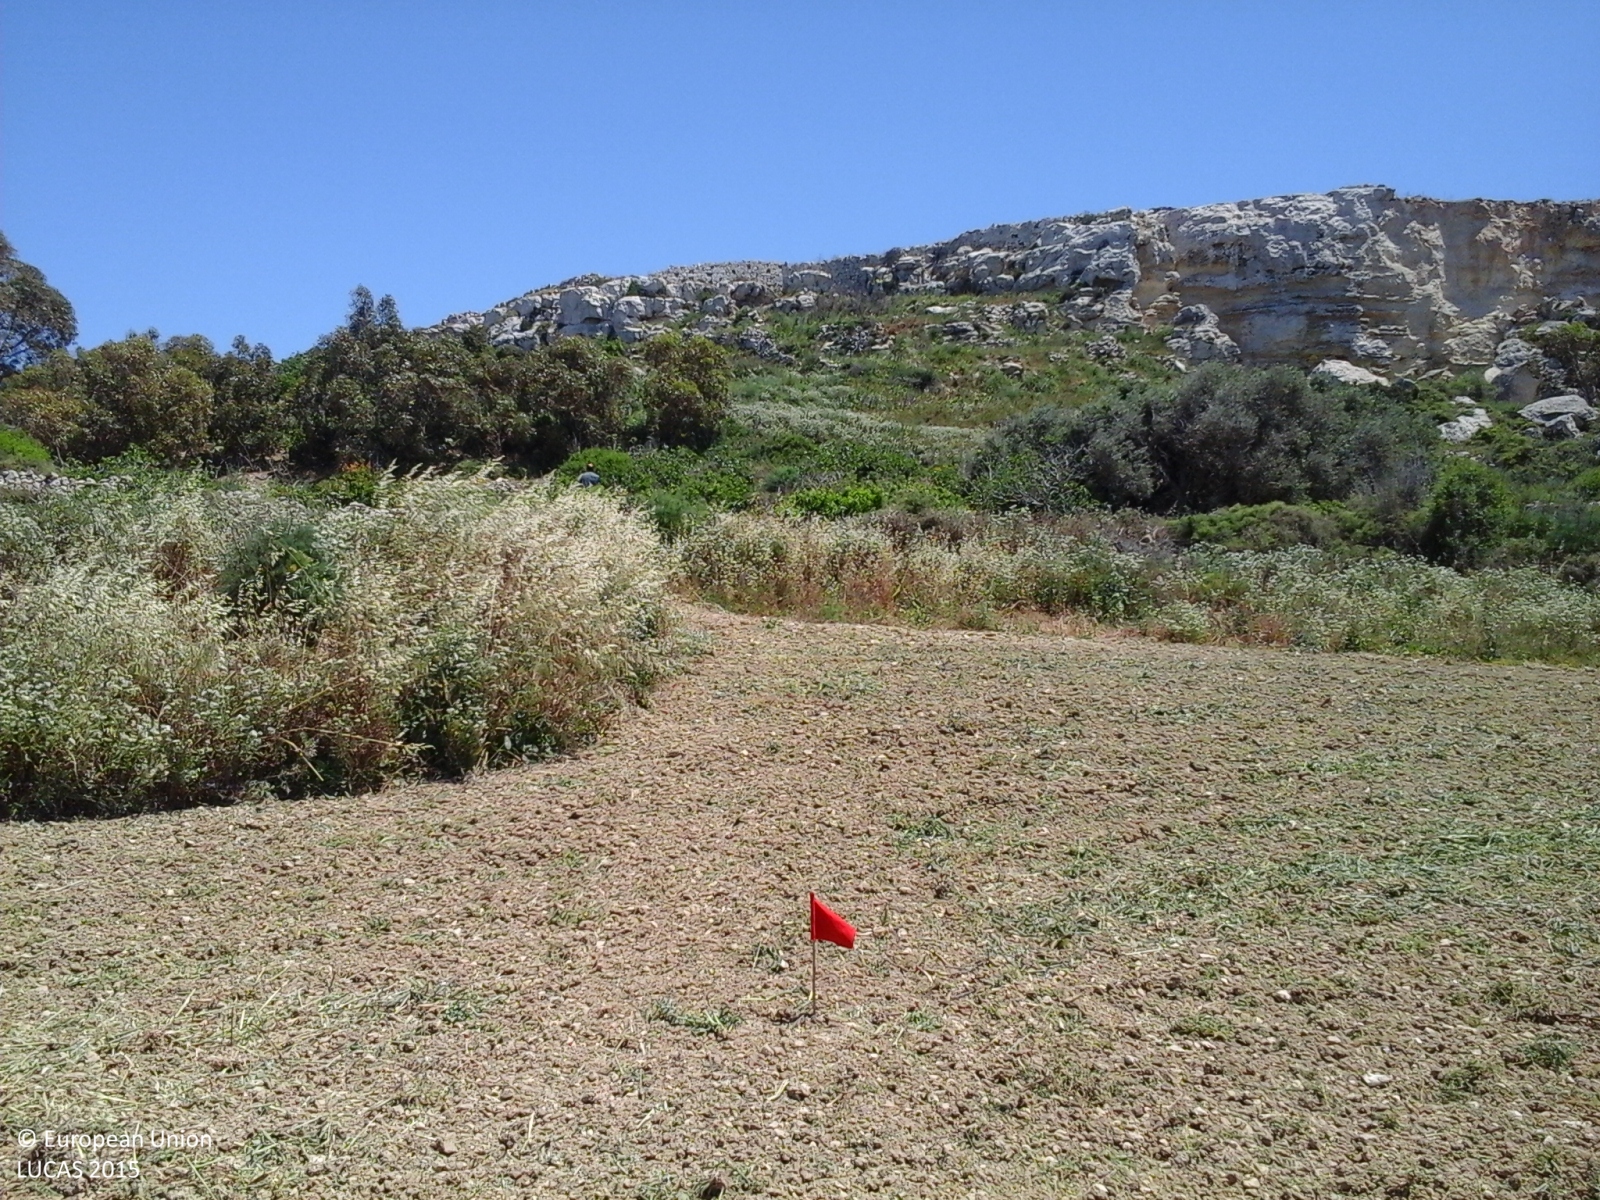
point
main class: Cropland
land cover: Dry pulses
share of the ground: > 75 %
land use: Agriculture (excluding fallow land and kitchen gardens)
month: May
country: MT
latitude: 35.9007
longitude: 14.3582
